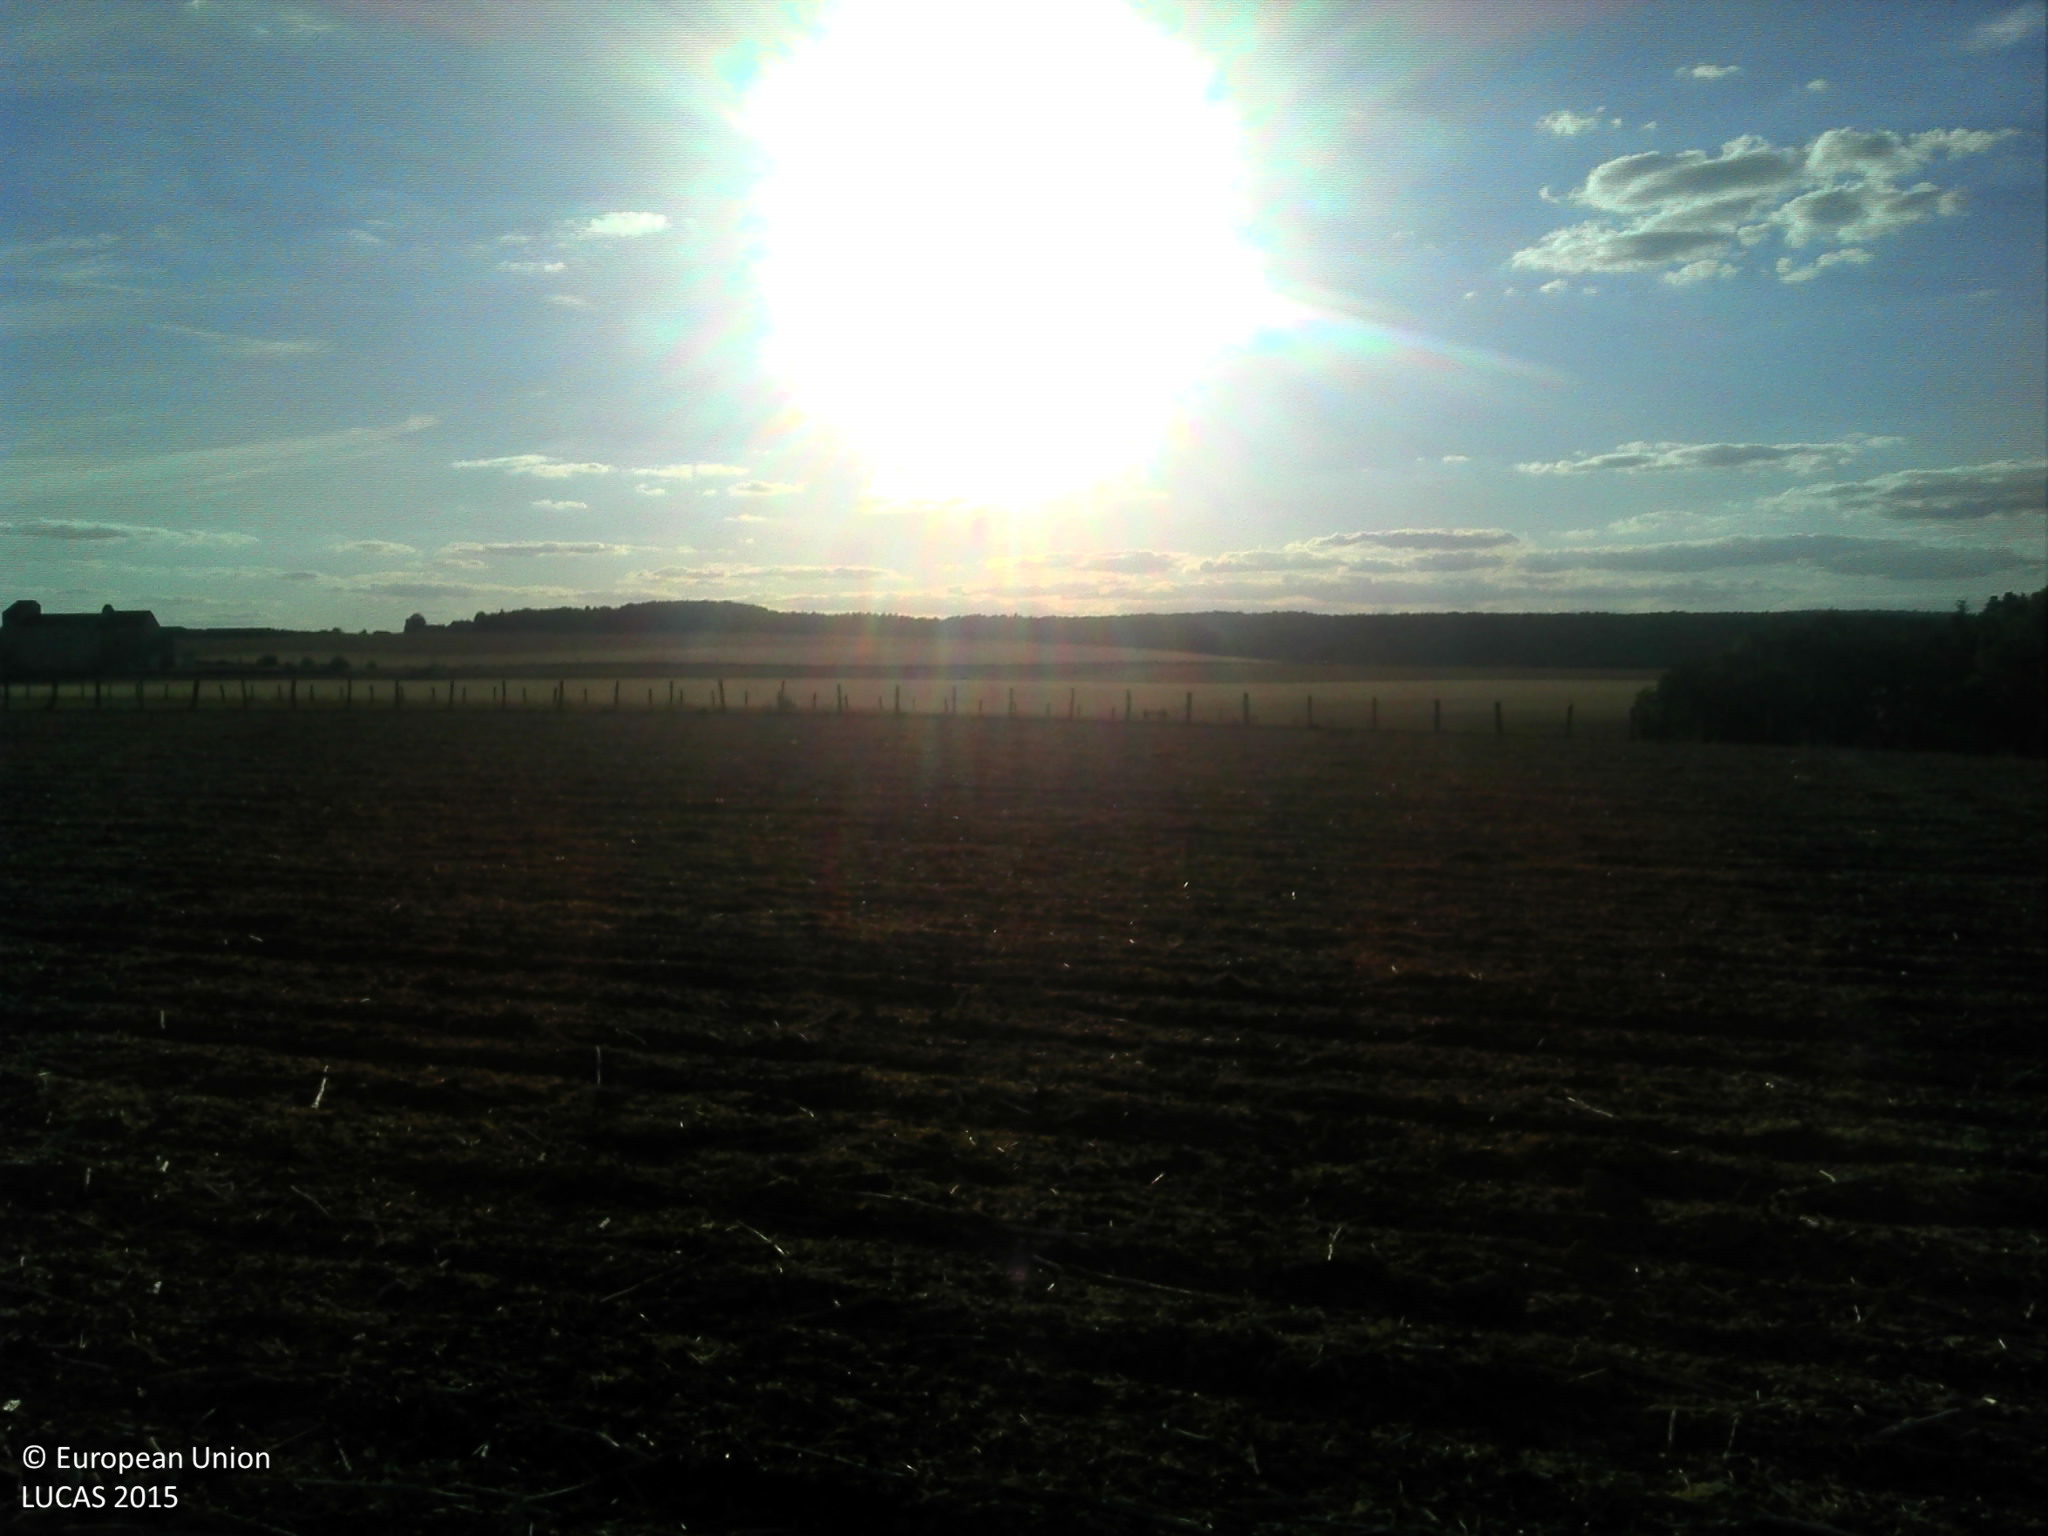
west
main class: Cropland
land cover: Rape and turnip rape
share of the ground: < 10 %
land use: Agriculture (excluding fallow land and kitchen gardens)
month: July
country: FR
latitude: 47.6176
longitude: 5.2771
